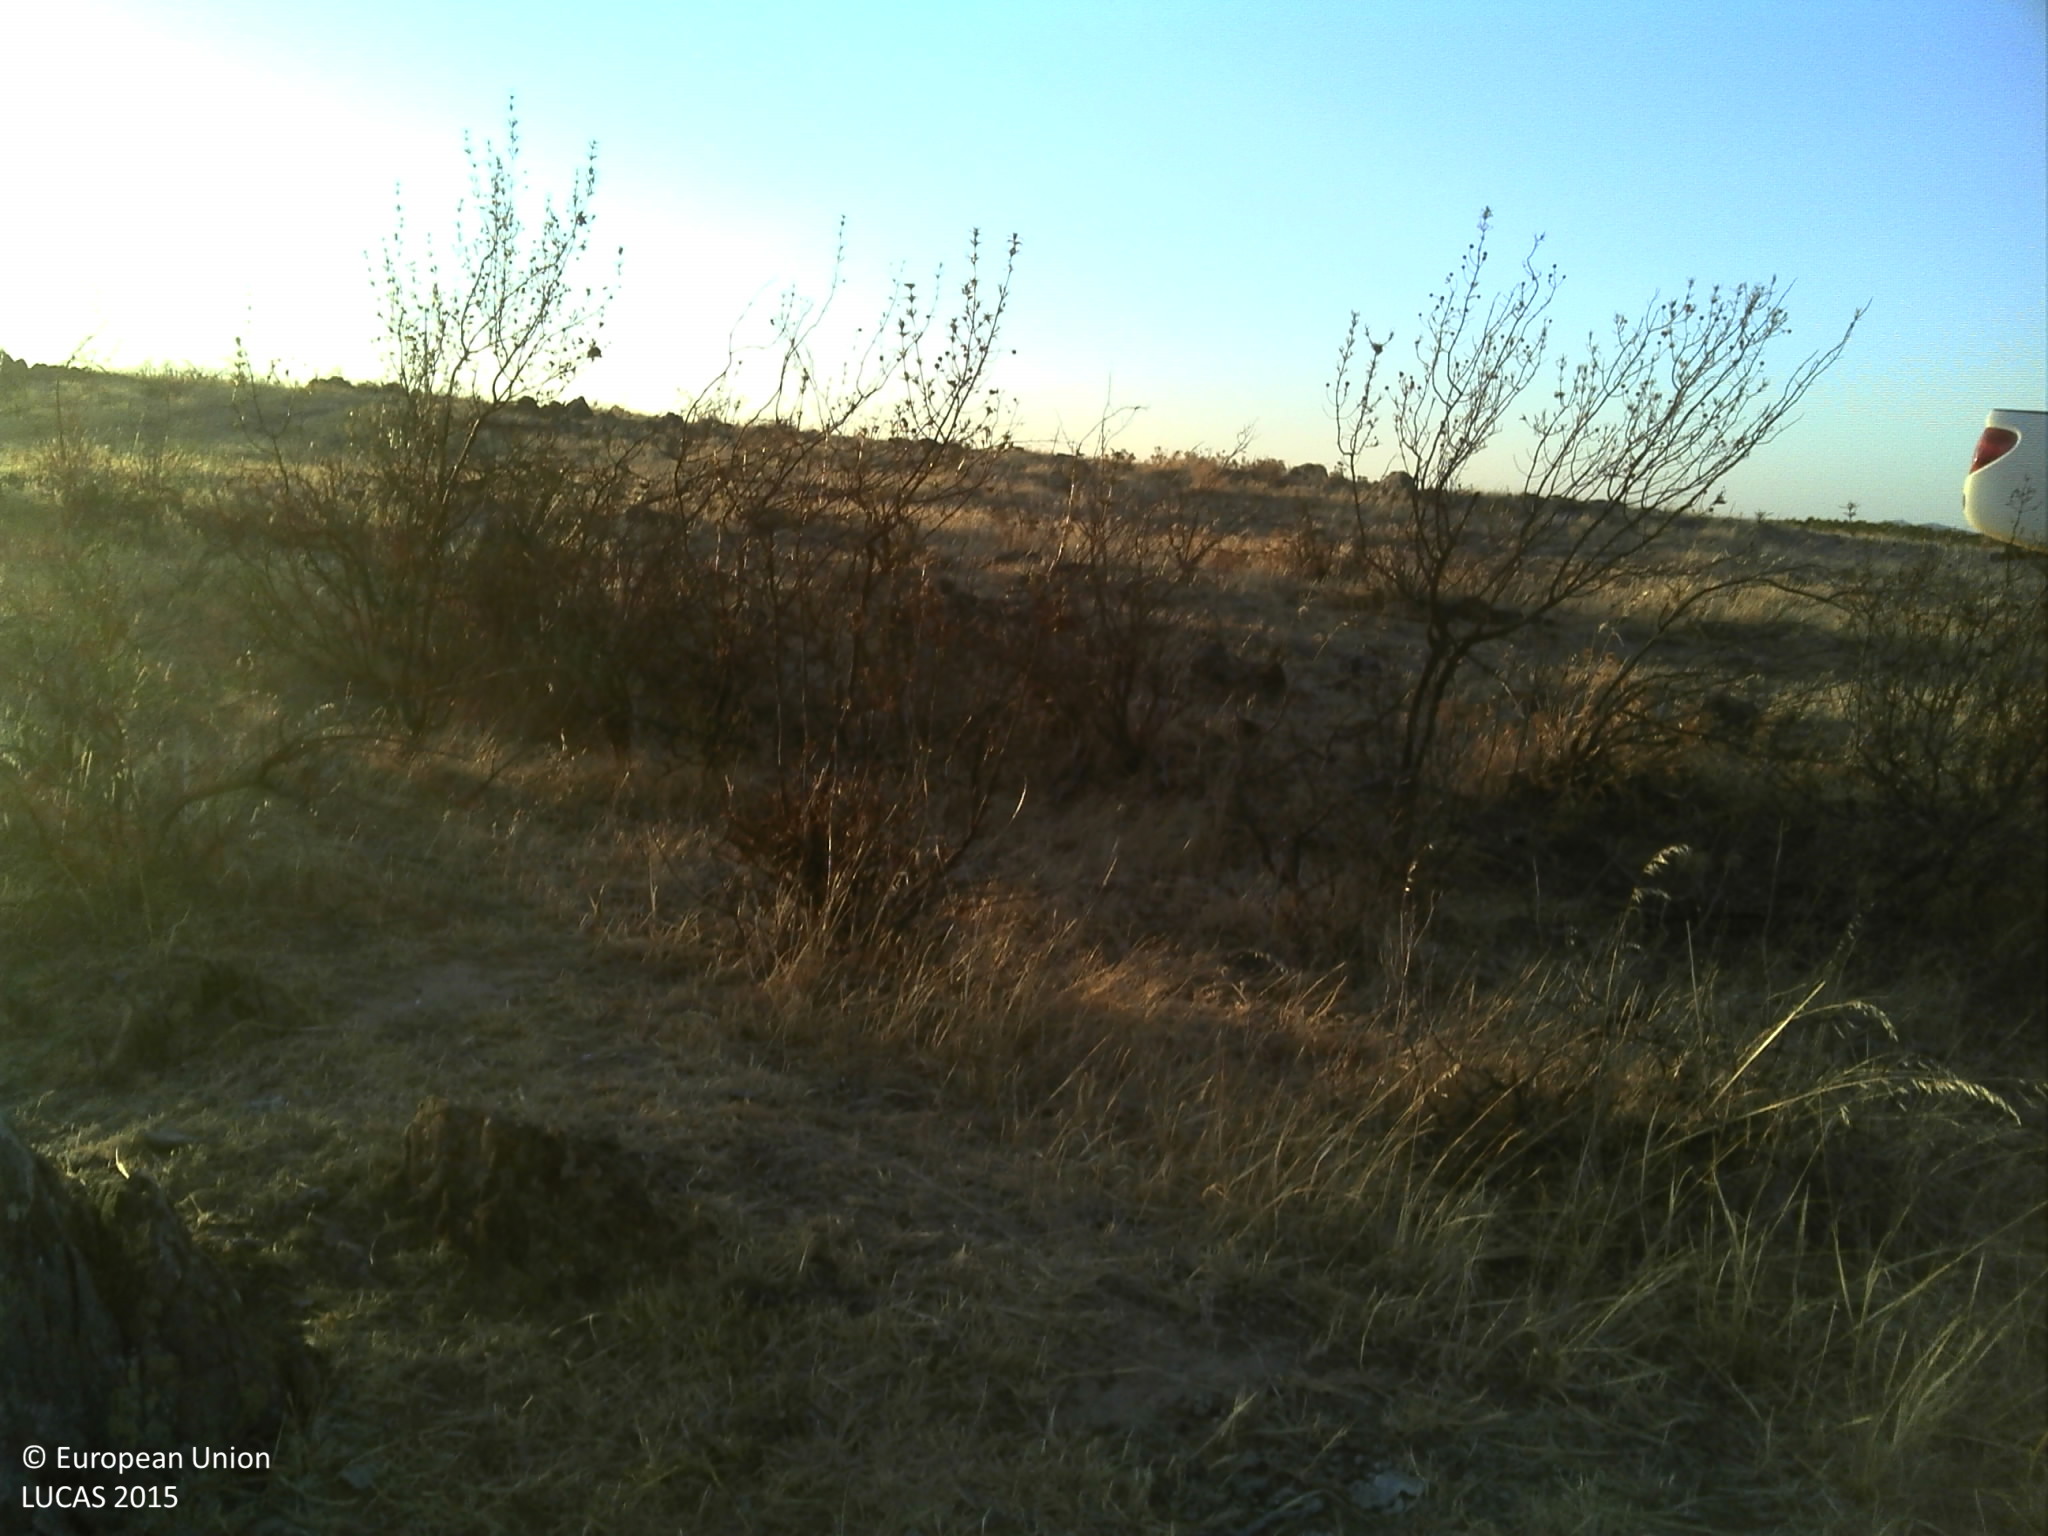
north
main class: Shrubland
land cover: Shrubland without tree cover
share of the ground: 10 - 25 %
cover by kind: unconsolidated bare surface 55 %, shrubs 20 %, herbaceous plants 20 %, consolidated bare surface 5 %
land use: Agriculture (excluding fallow land and kitchen gardens)
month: July
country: PT
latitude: 37.6279
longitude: -7.8893
